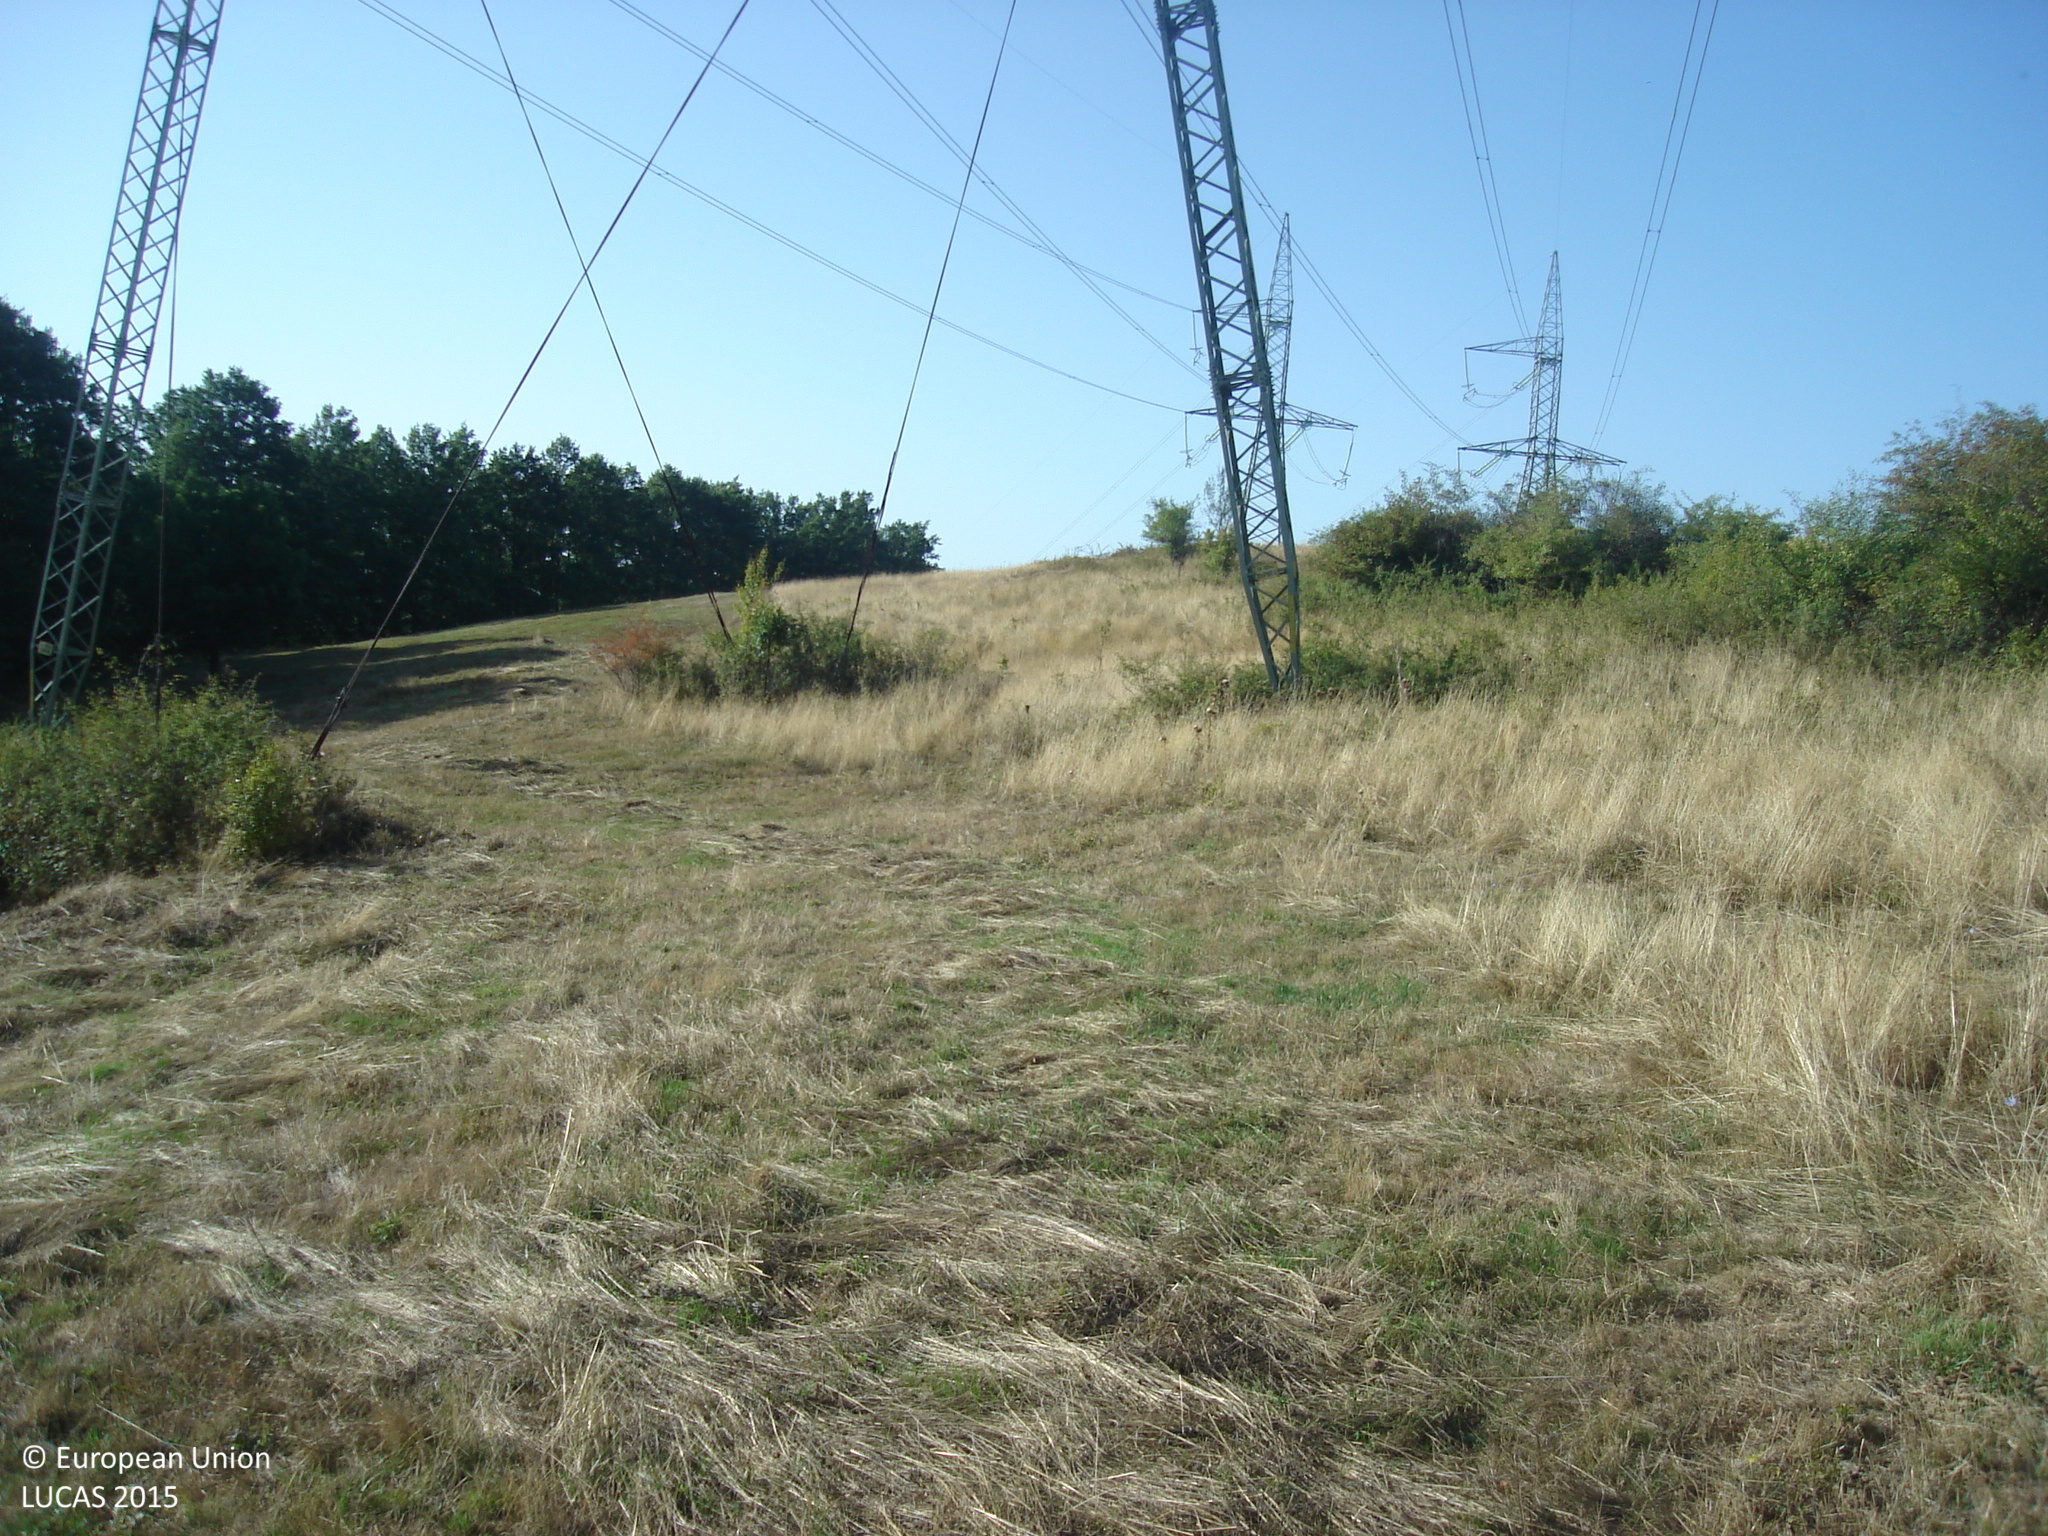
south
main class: Grassland
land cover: Grassland without tree/shrub cover
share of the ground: > 75 %
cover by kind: herbaceous plants 100 %
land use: Agriculture (excluding fallow land and kitchen gardens)
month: September
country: BG
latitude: 42.9328
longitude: 23.2322
